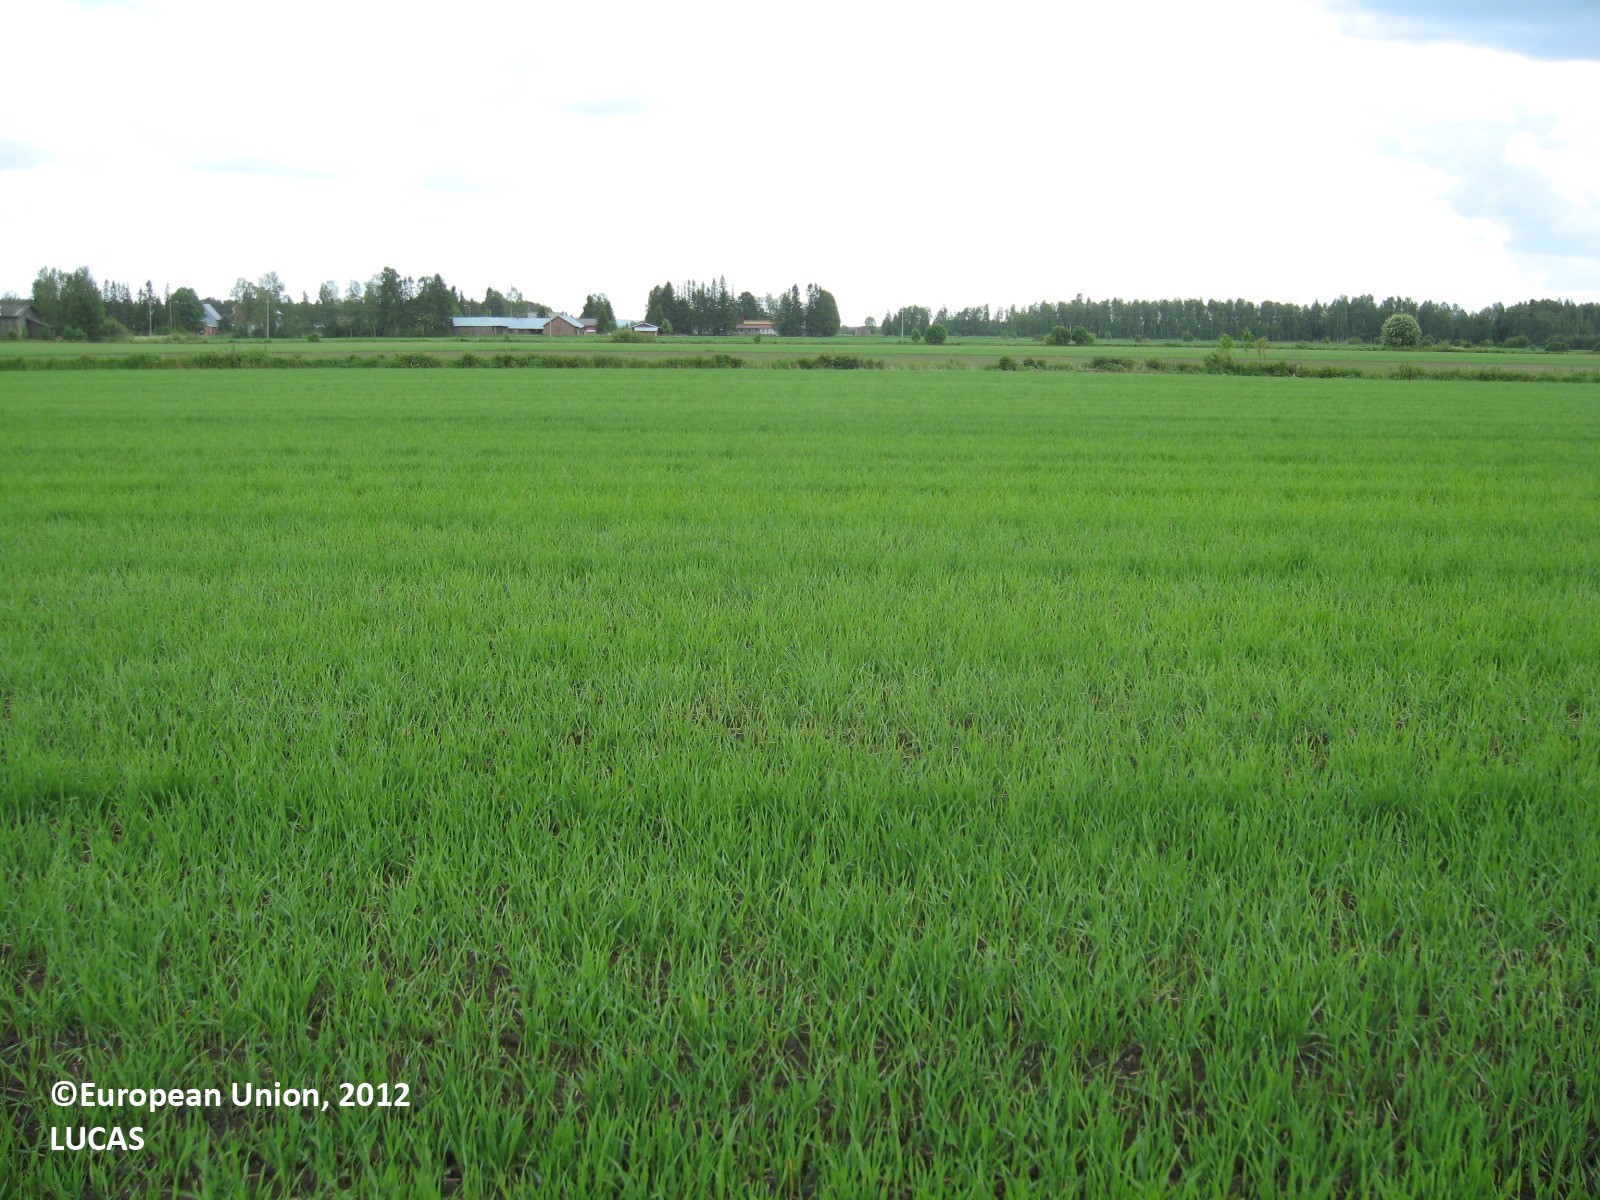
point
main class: Cropland
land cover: Barley
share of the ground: > 75 %
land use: Agriculture (excluding fallow land and kitchen gardens)
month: June
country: FI
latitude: 63.0658
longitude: 22.8590
